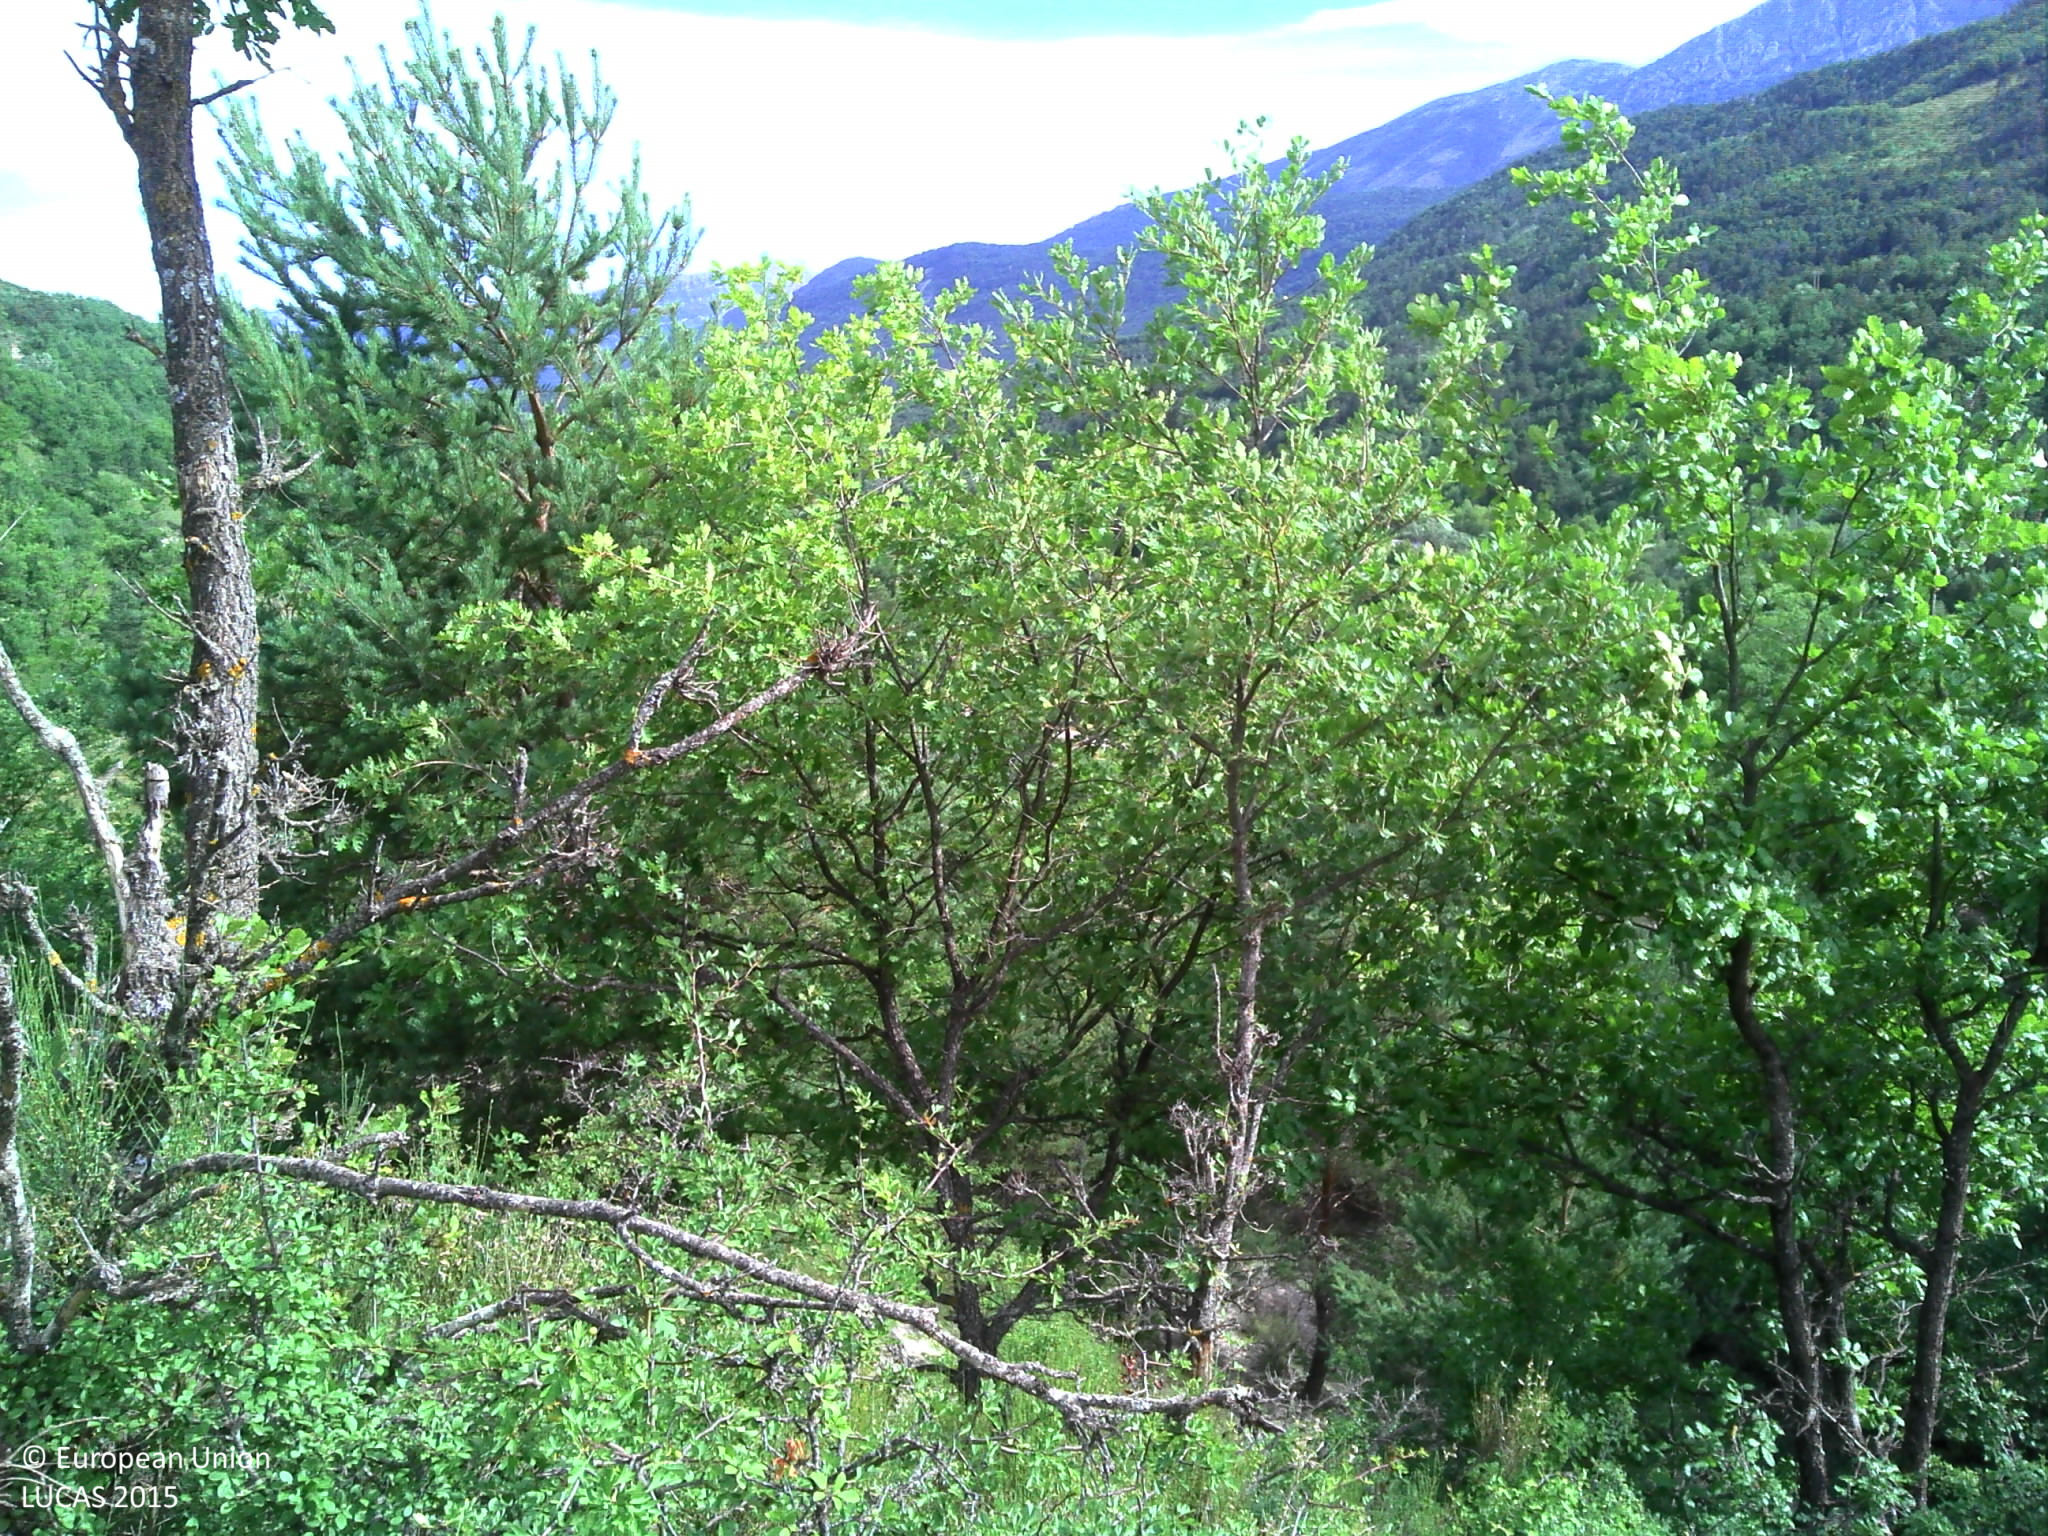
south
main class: Shrubland
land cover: Shrubland with sparse tree cover
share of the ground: > 75 %
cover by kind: shrubs 50 %, consolidated bare surface 35 %, herbaceous plants 10 %, broadleaved forest trees 5 %
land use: Agriculture (excluding fallow land and kitchen gardens)
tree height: > 5 m
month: July
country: FR
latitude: 43.9445
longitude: 6.3820
